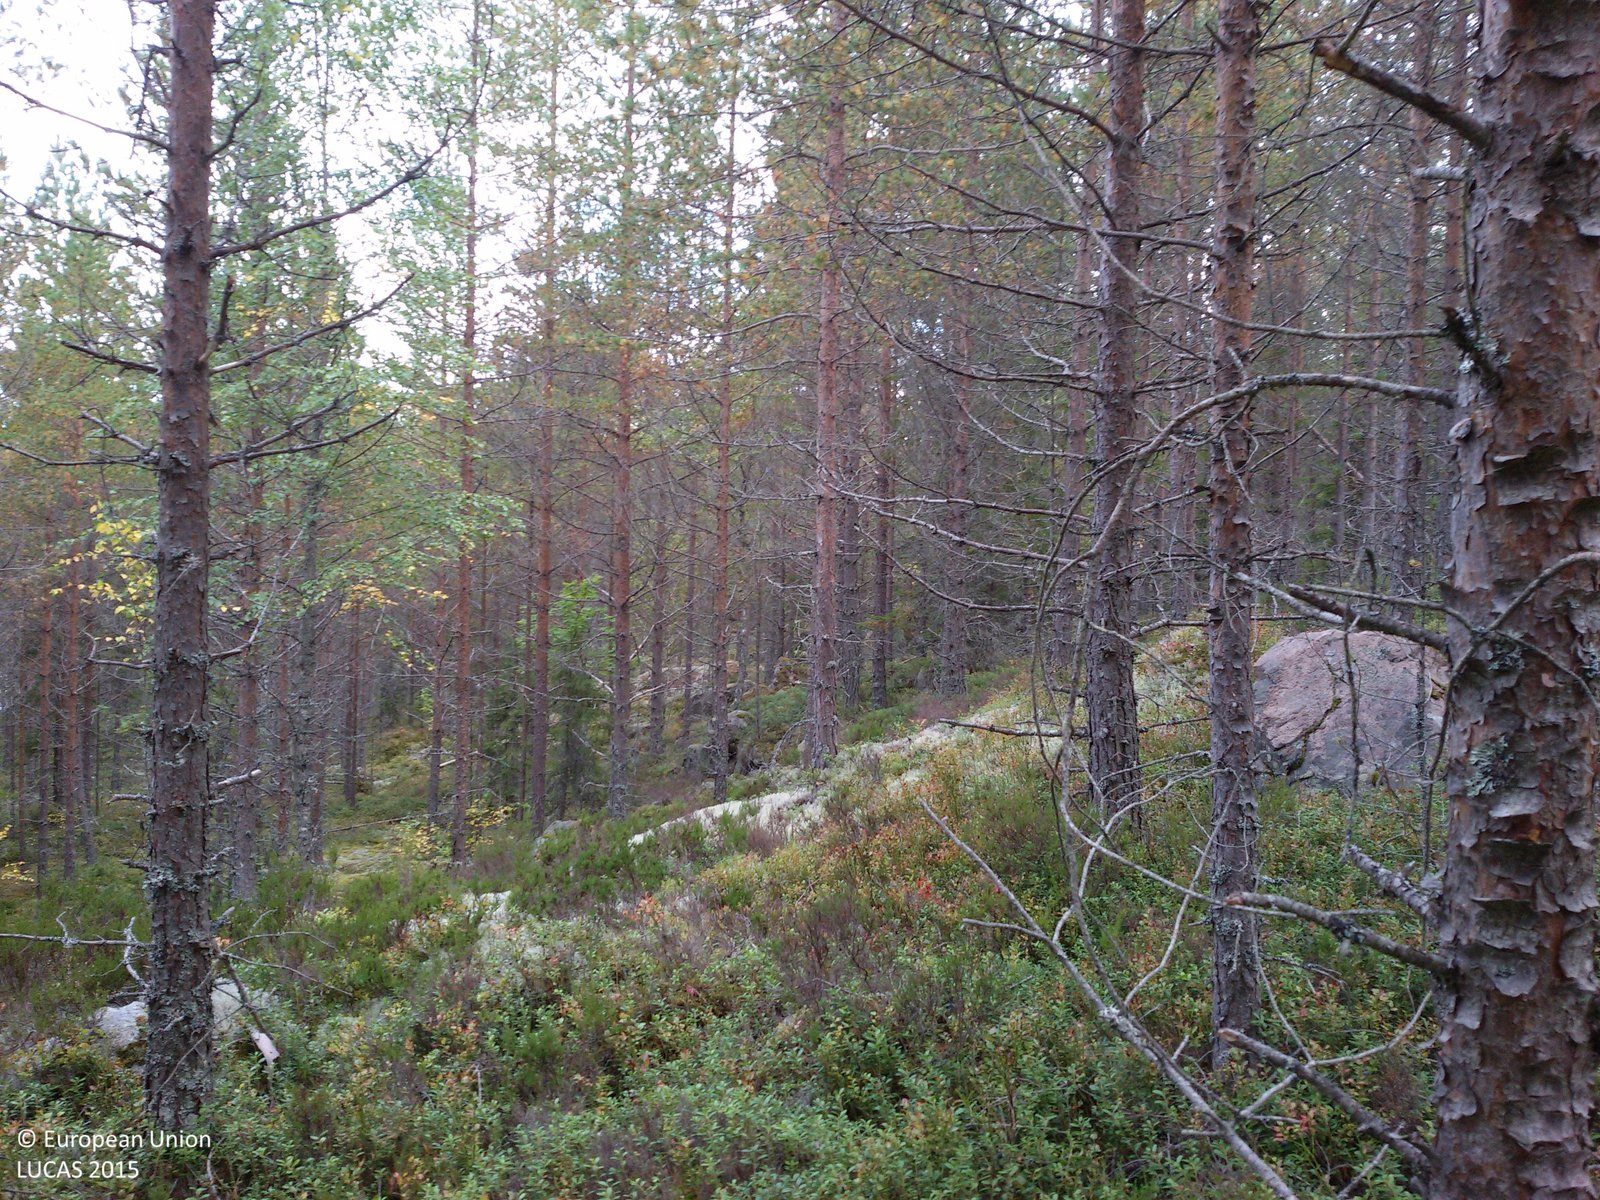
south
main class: Woodland
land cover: Pine dominated coniferous woodland
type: boreal forest
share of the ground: > 75 %
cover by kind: coniferous forest trees 80 %, shrubs 10 %, lichens and mosses 10 %
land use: Forestry
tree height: > 5 m
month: September
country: SE
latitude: 60.7182
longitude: 14.6246
